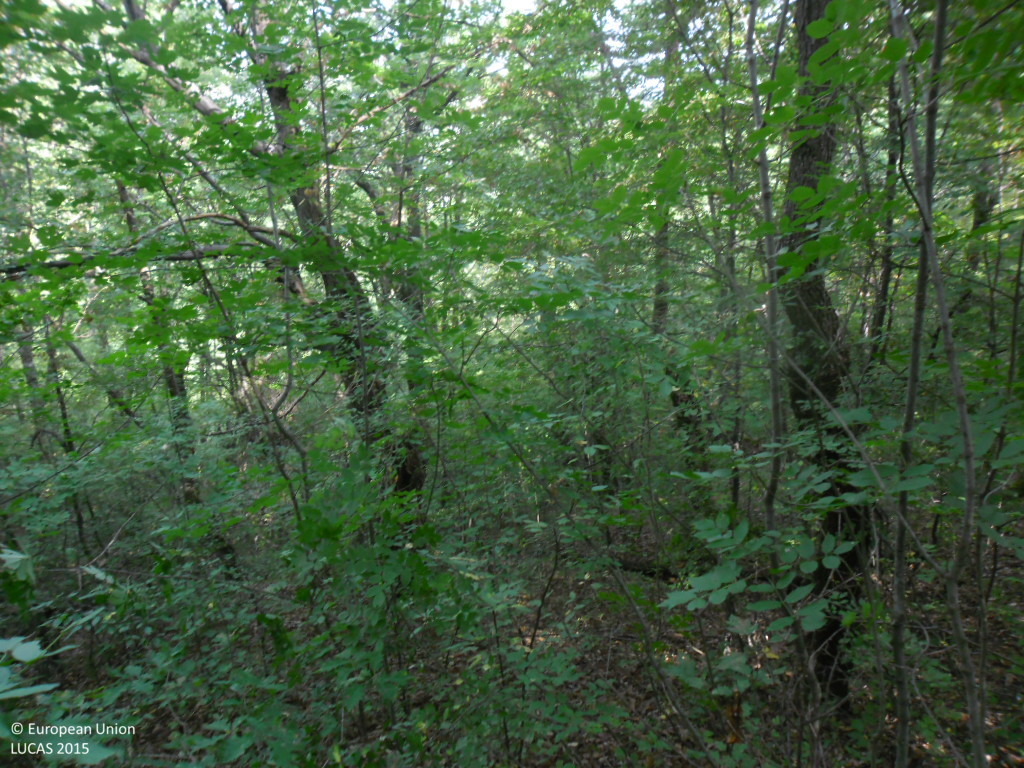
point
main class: Woodland
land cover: Broadleaved woodland
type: mountainous beech forest
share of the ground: > 75 %
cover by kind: broadleaved forest trees 95 %, unconsolidated bare surface 5 %
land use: Forestry
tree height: > 5 m
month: September
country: BG
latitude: 41.8675
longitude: 22.9969
